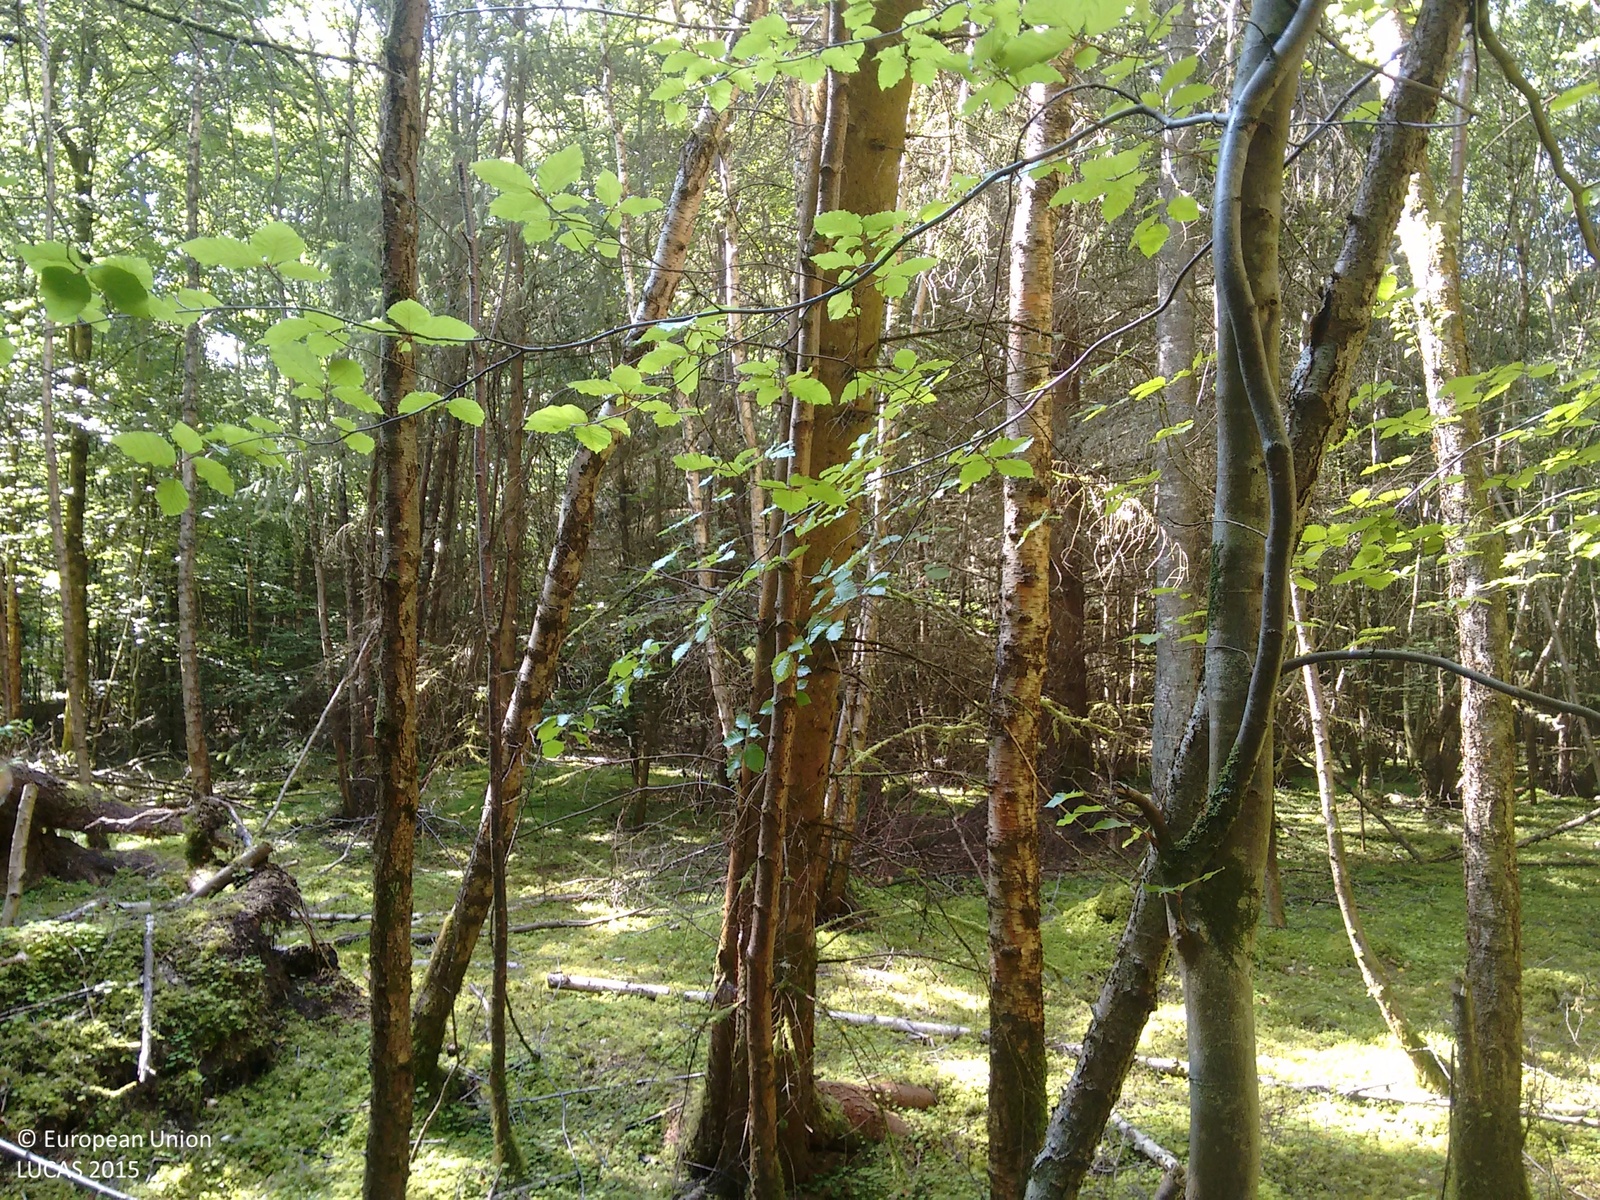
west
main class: Woodland
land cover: Spruce dominated mixed woodland
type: exotic forest
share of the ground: > 75 %
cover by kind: coniferous forest trees 70 %, broadleaved forest trees 30 %
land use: Forestry
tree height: > 5 m
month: August
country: GB
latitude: 57.7515
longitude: -4.0431
